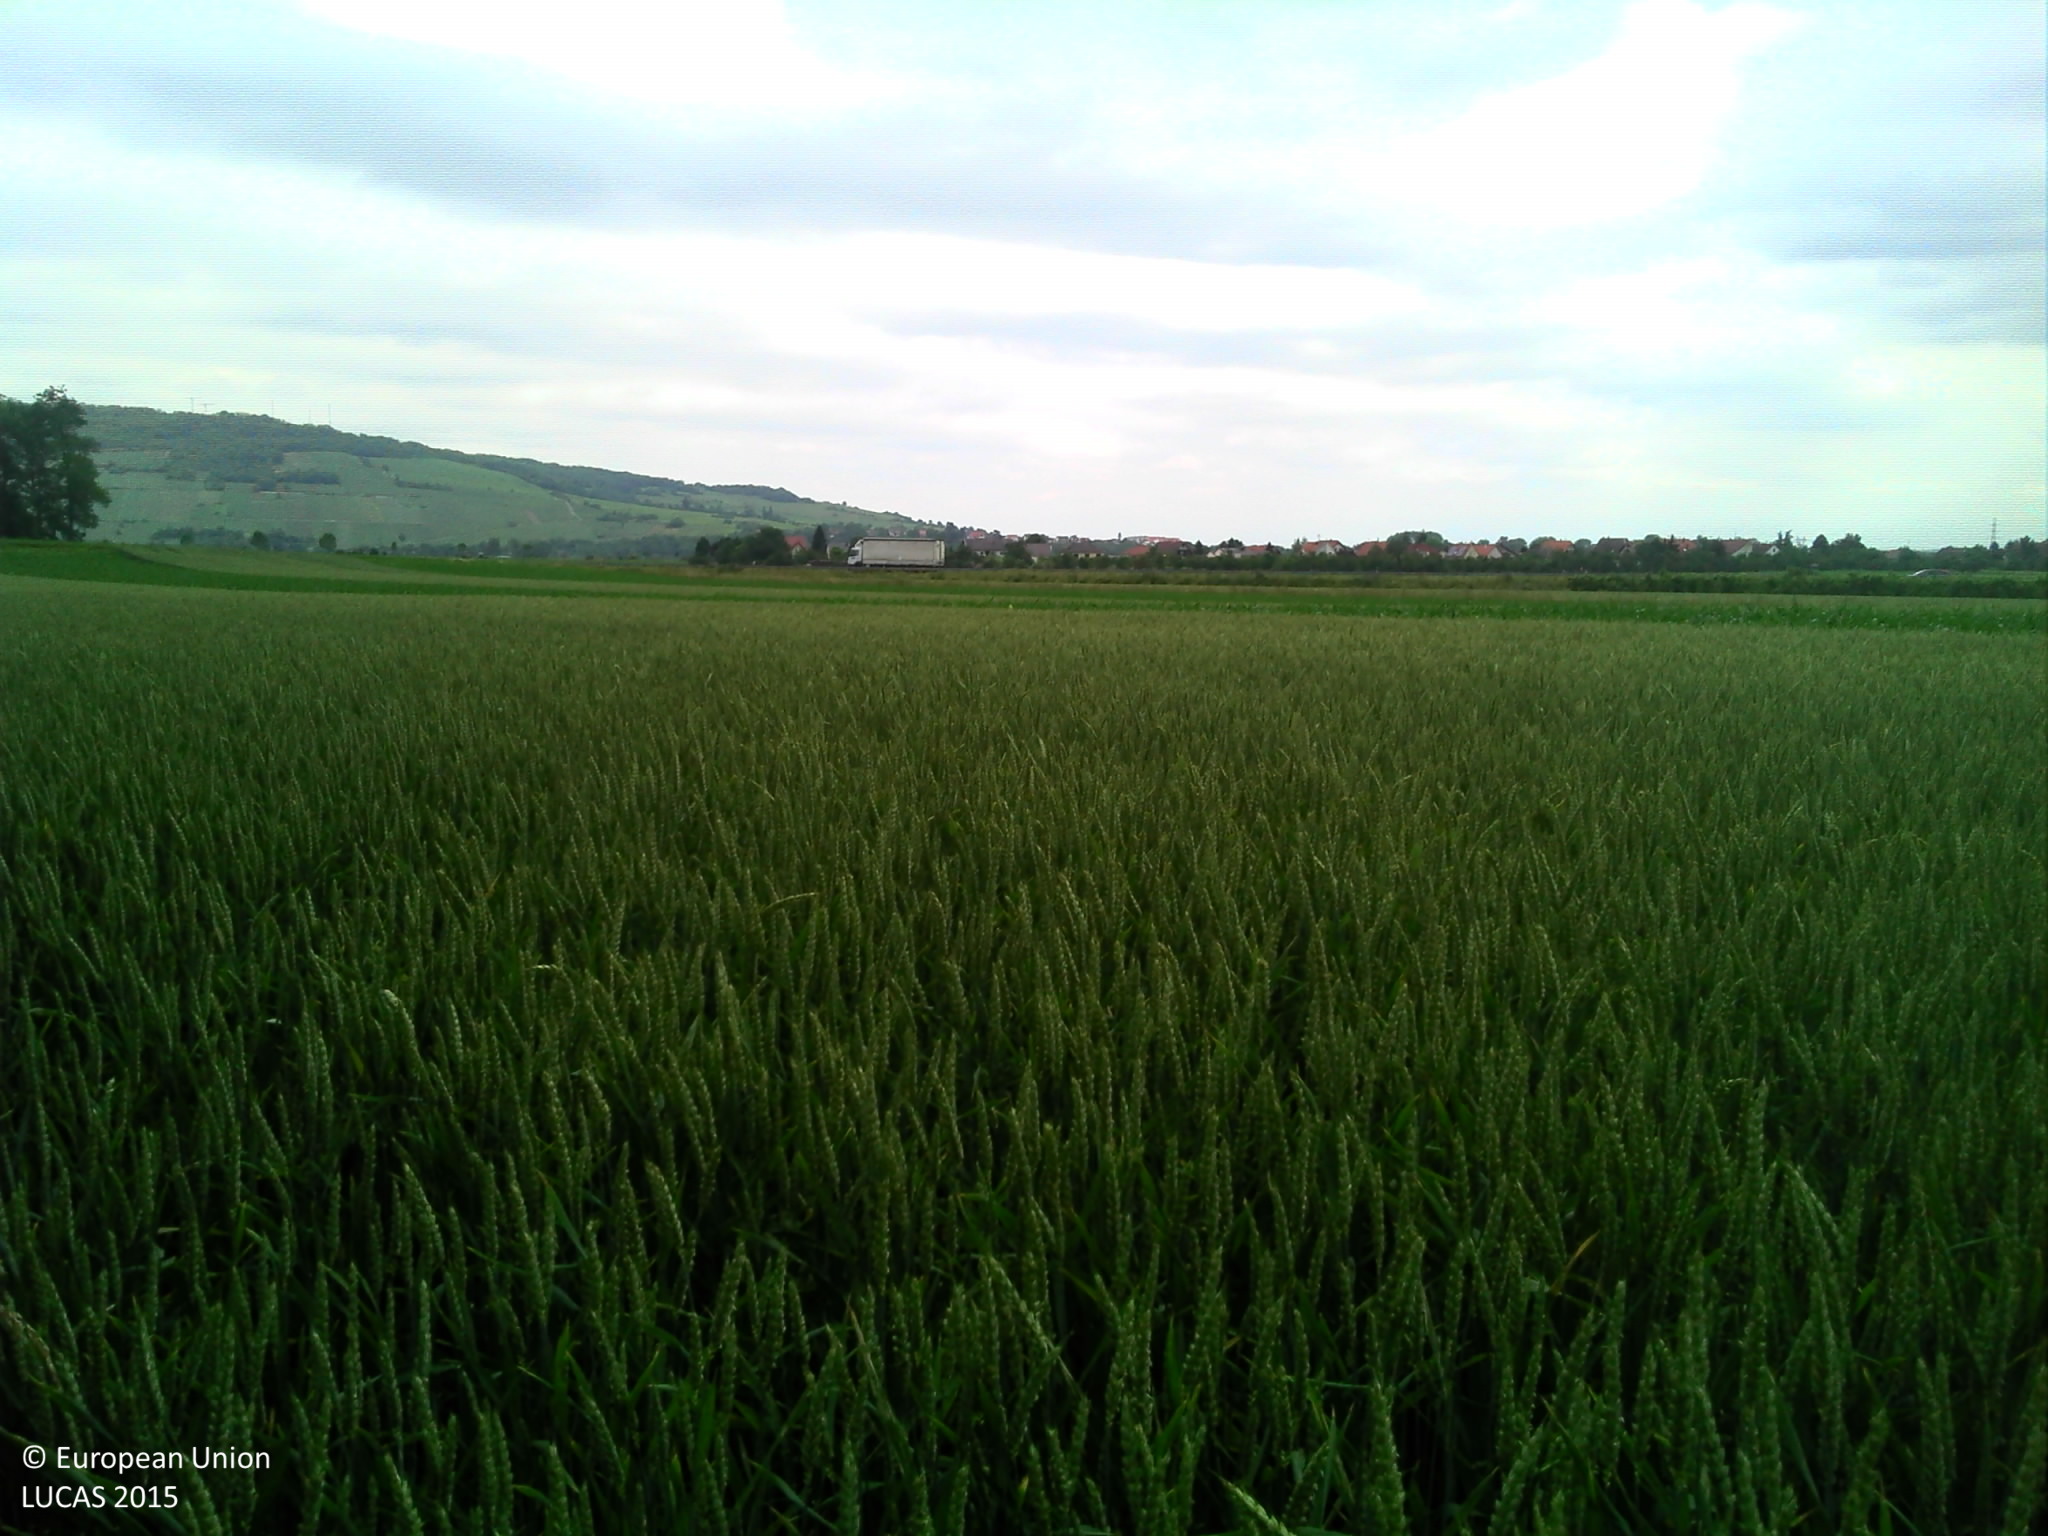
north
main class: Cropland
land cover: Nuts trees
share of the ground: > 75 %
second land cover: Grassland without tree/shrub cover
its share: > 75 %
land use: Agriculture (excluding fallow land and kitchen gardens)
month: June
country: FR
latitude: 48.5186
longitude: 7.4691
